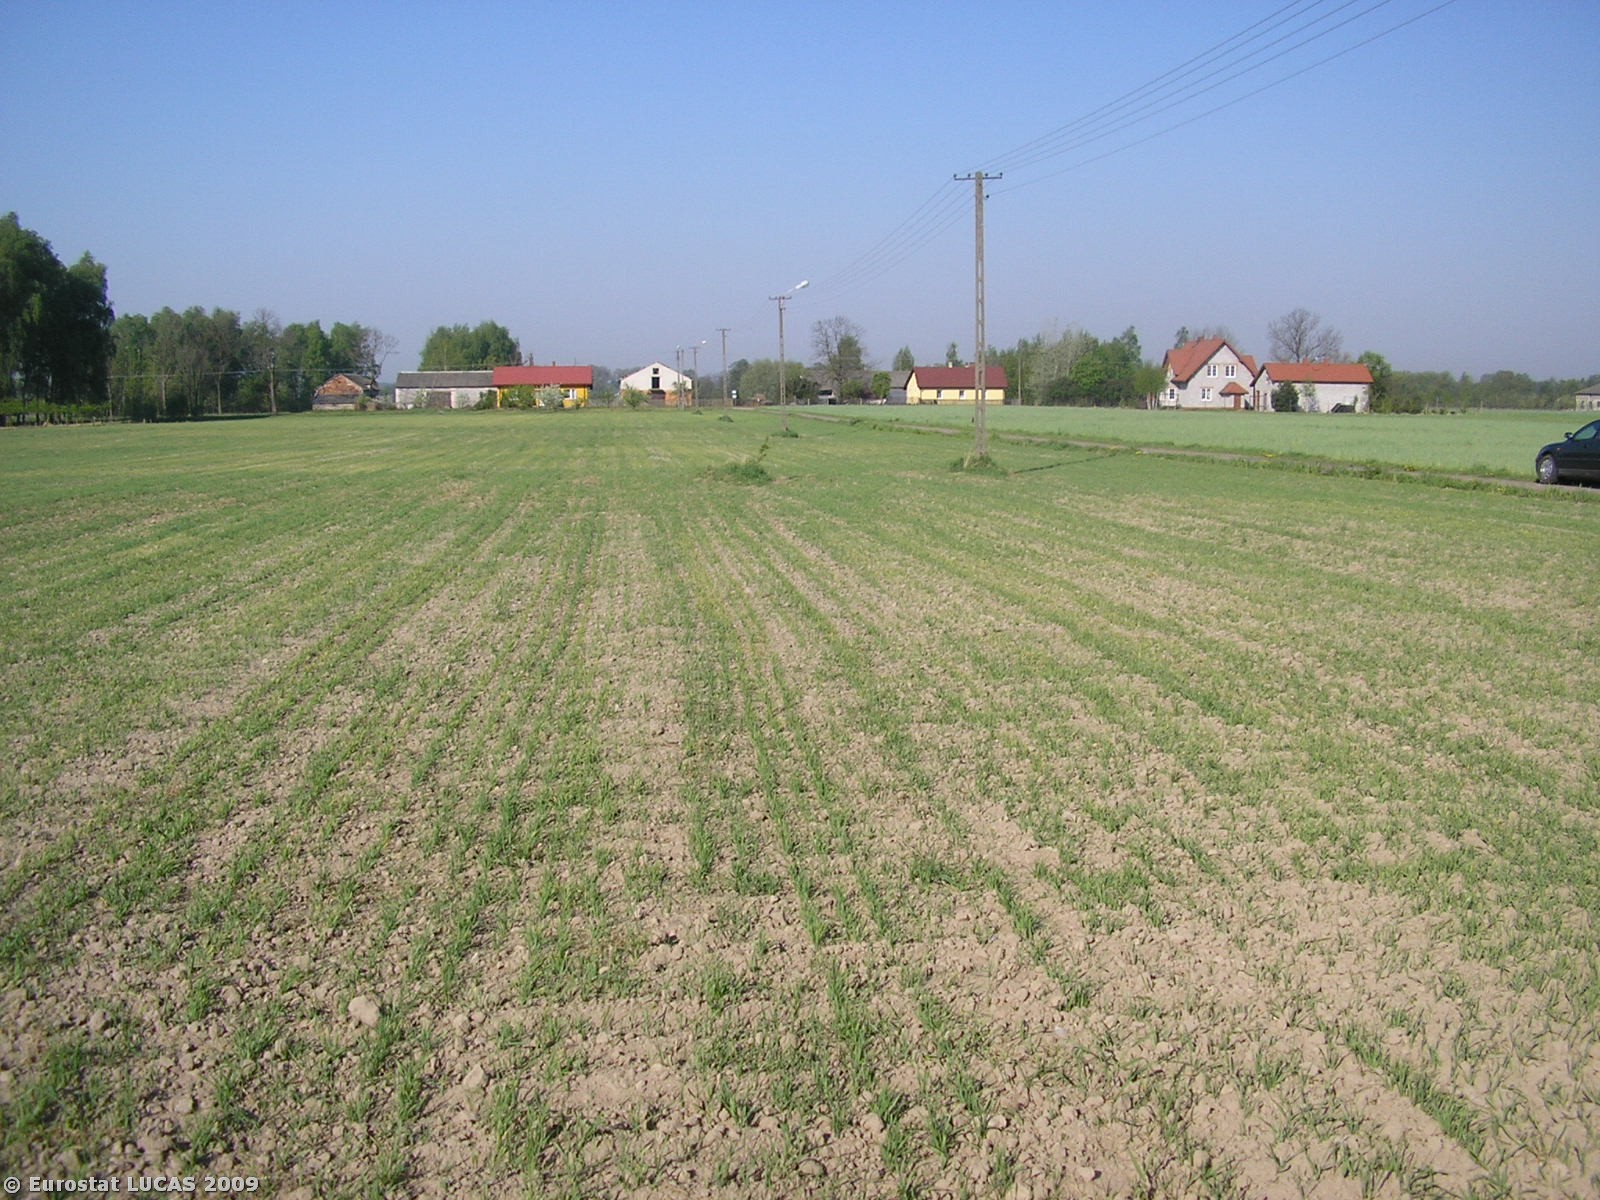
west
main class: Cropland
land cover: Mixed cereals for fodder
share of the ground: < 10 %
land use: Agriculture (excluding fallow land and kitchen gardens)
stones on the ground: < 10 %
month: April
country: PL
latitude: 52.2109
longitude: 20.1765
